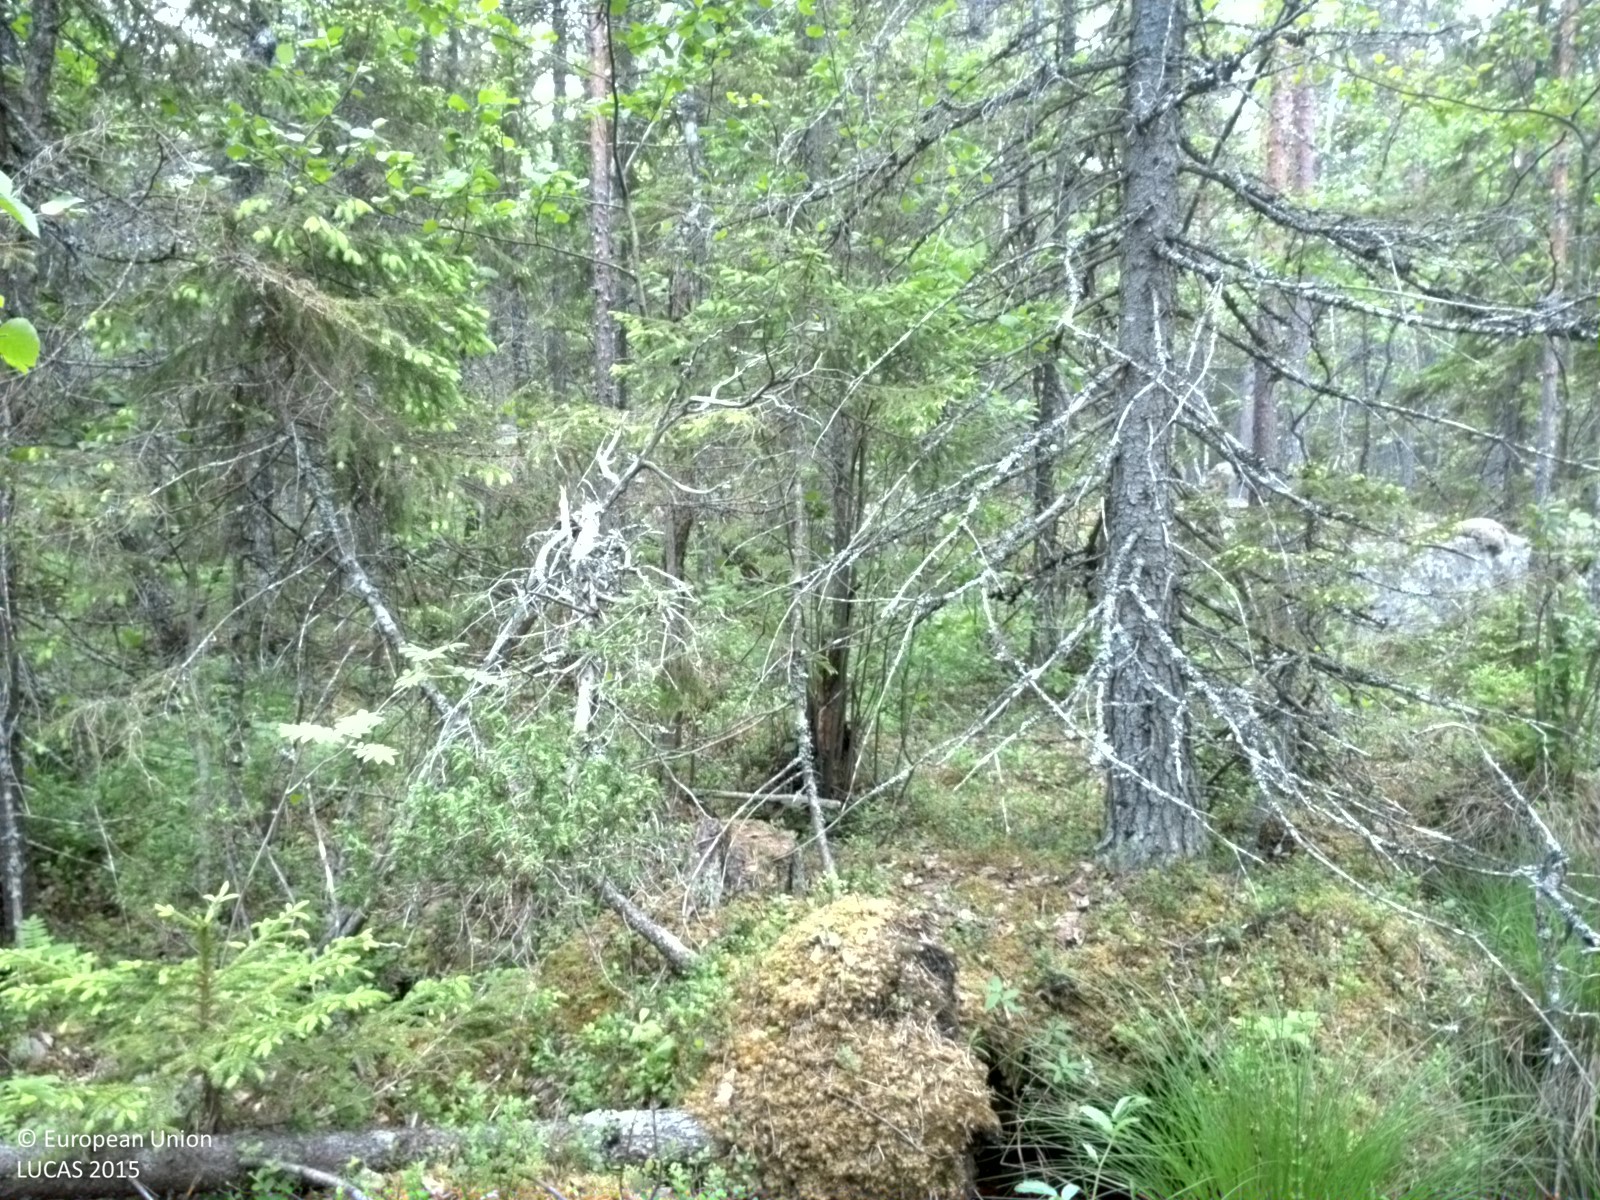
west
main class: Woodland
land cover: Other mixed woodland
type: boreal forest
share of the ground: 50 - 75 %
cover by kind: broadleaved forest trees 35 %, herbaceous plants 30 %, coniferous forest trees 25 %, lichens and mosses 5 %, consolidated bare surface 5 %
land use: Semi-natural and natural areas not in use
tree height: > 5 m
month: June
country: SE
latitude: 60.2692
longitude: 17.8569
